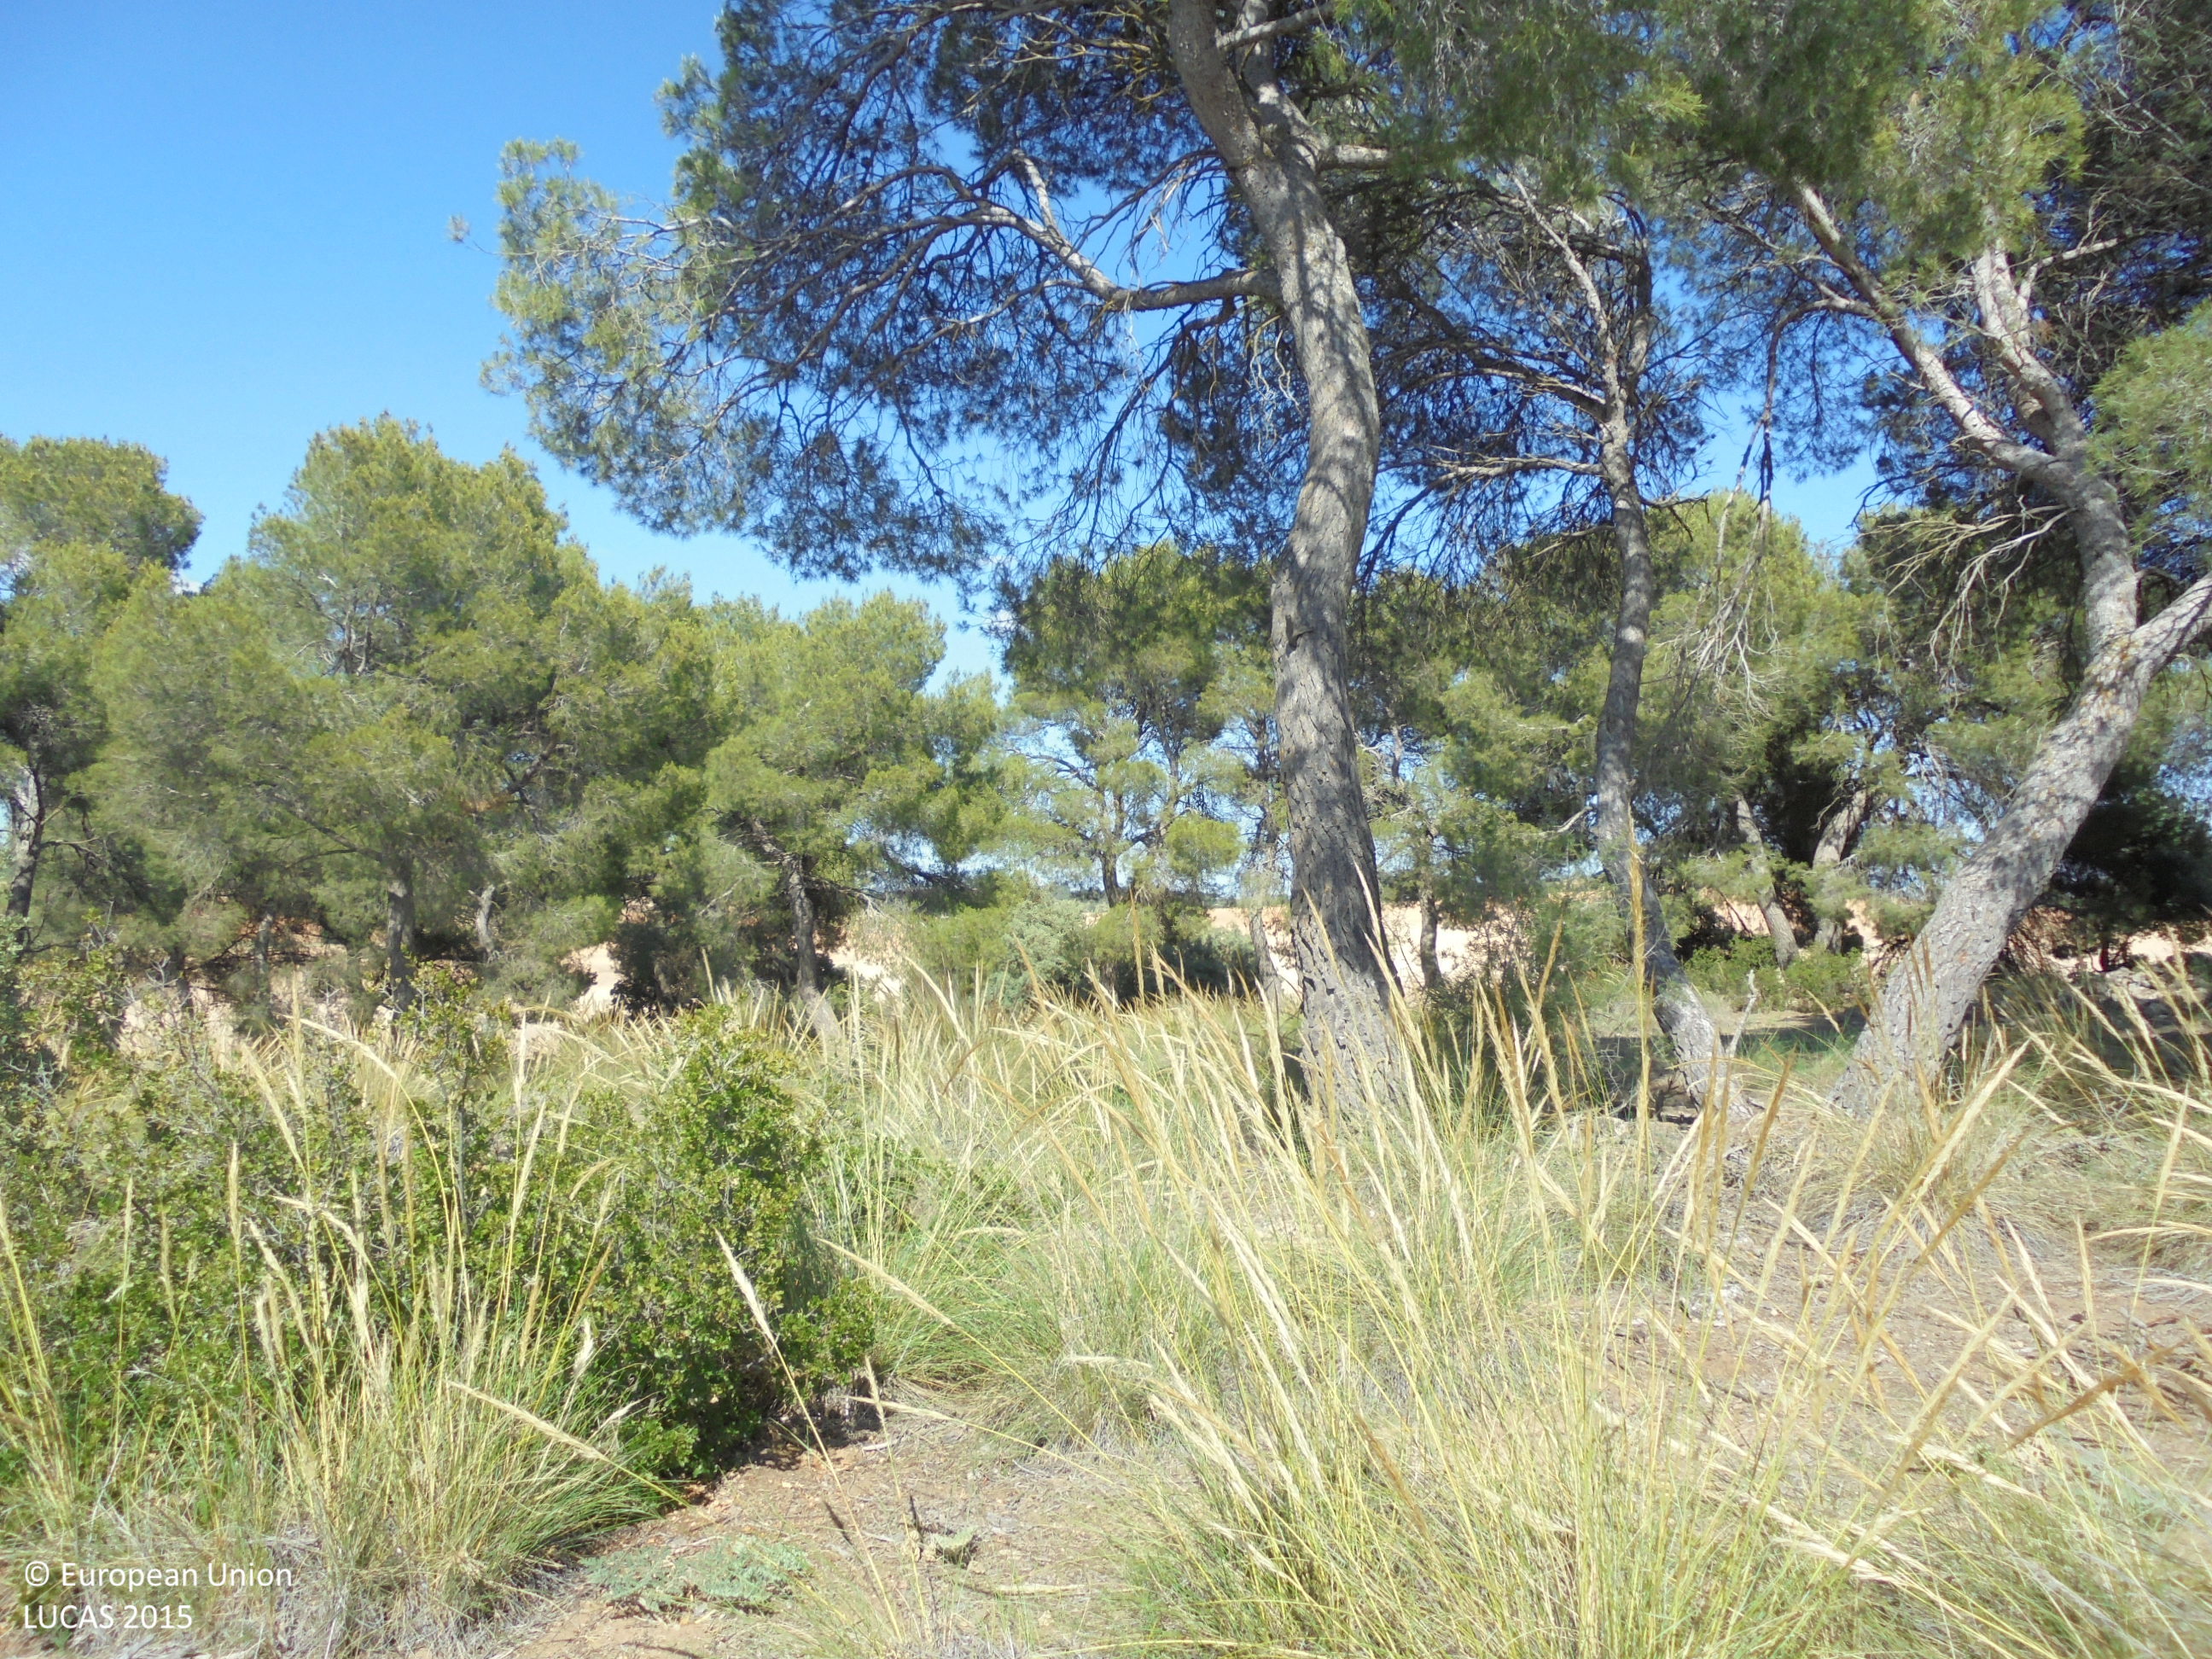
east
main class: Woodland
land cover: Pine dominated coniferous woodland
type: coniferous forest of the mediterranean region
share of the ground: 50 - 75 %
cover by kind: coniferous forest trees 60 %, shrubs 30 %, unconsolidated bare surface 10 %
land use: Semi-natural and natural areas not in use
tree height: > 5 m
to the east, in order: Pine dominated coniferous woodland; Other bare soil
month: June
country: ES
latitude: 38.7635
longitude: -1.6774
